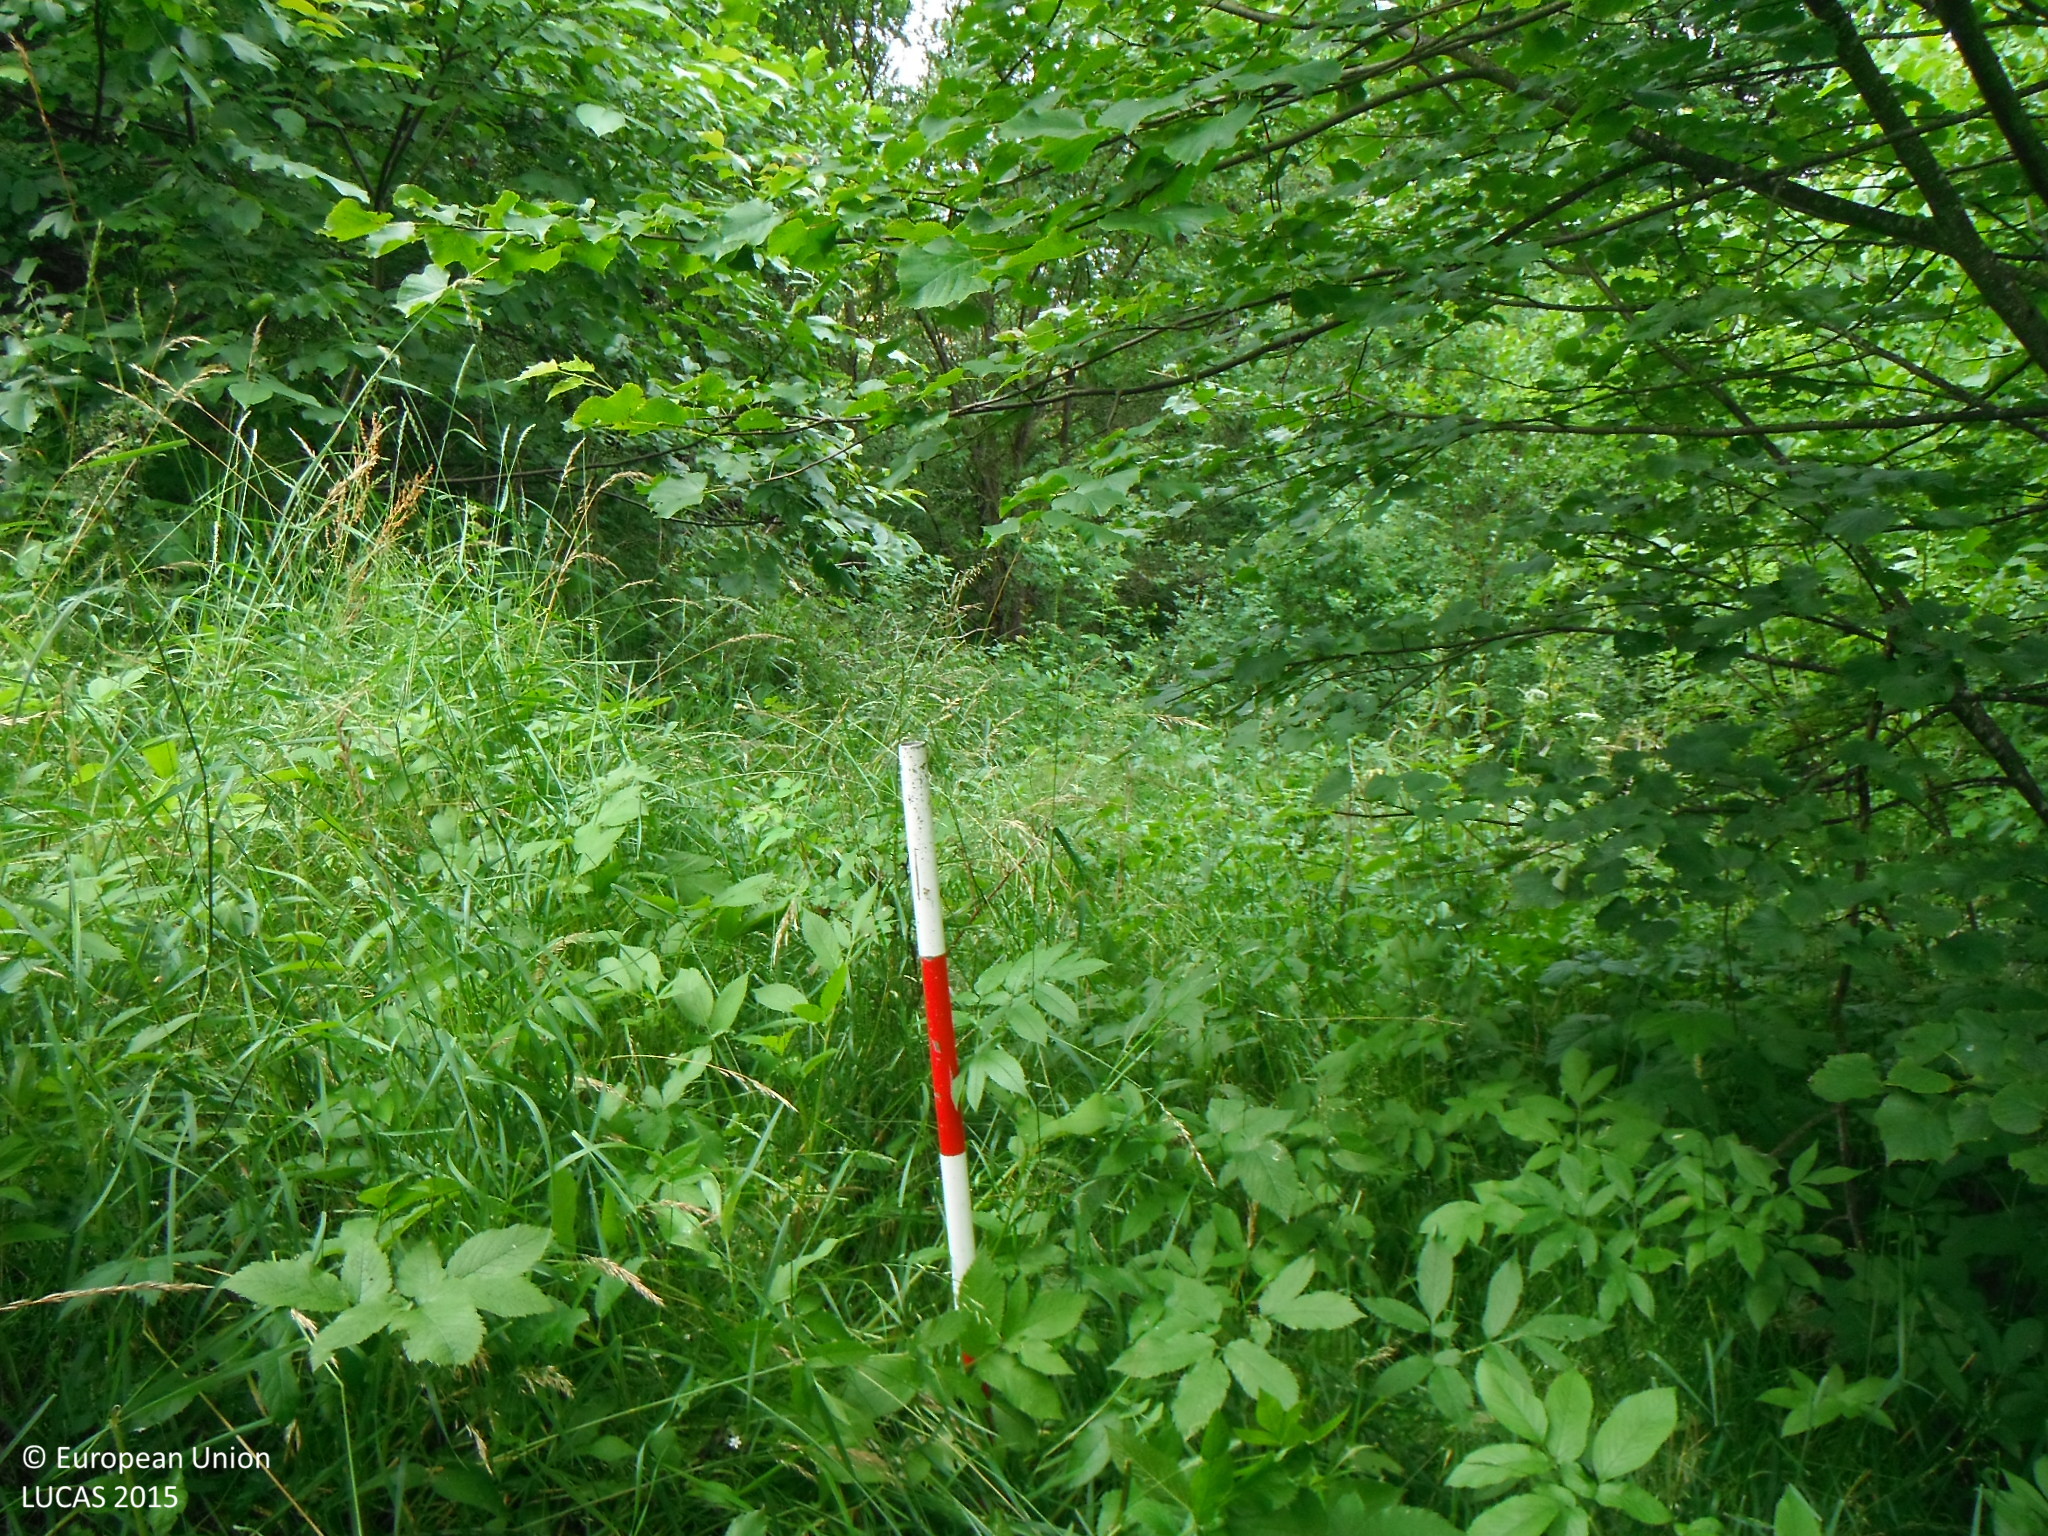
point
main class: Woodland
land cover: Broadleaved woodland
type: mesophytic deciduous forest
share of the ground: 25 - 50 %
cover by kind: broadleaved forest trees 60 %, herbaceous plants 30 %, shrubs 10 %
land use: Forestry
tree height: > 5 m
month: June
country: SK
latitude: 48.6780
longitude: 19.9576
